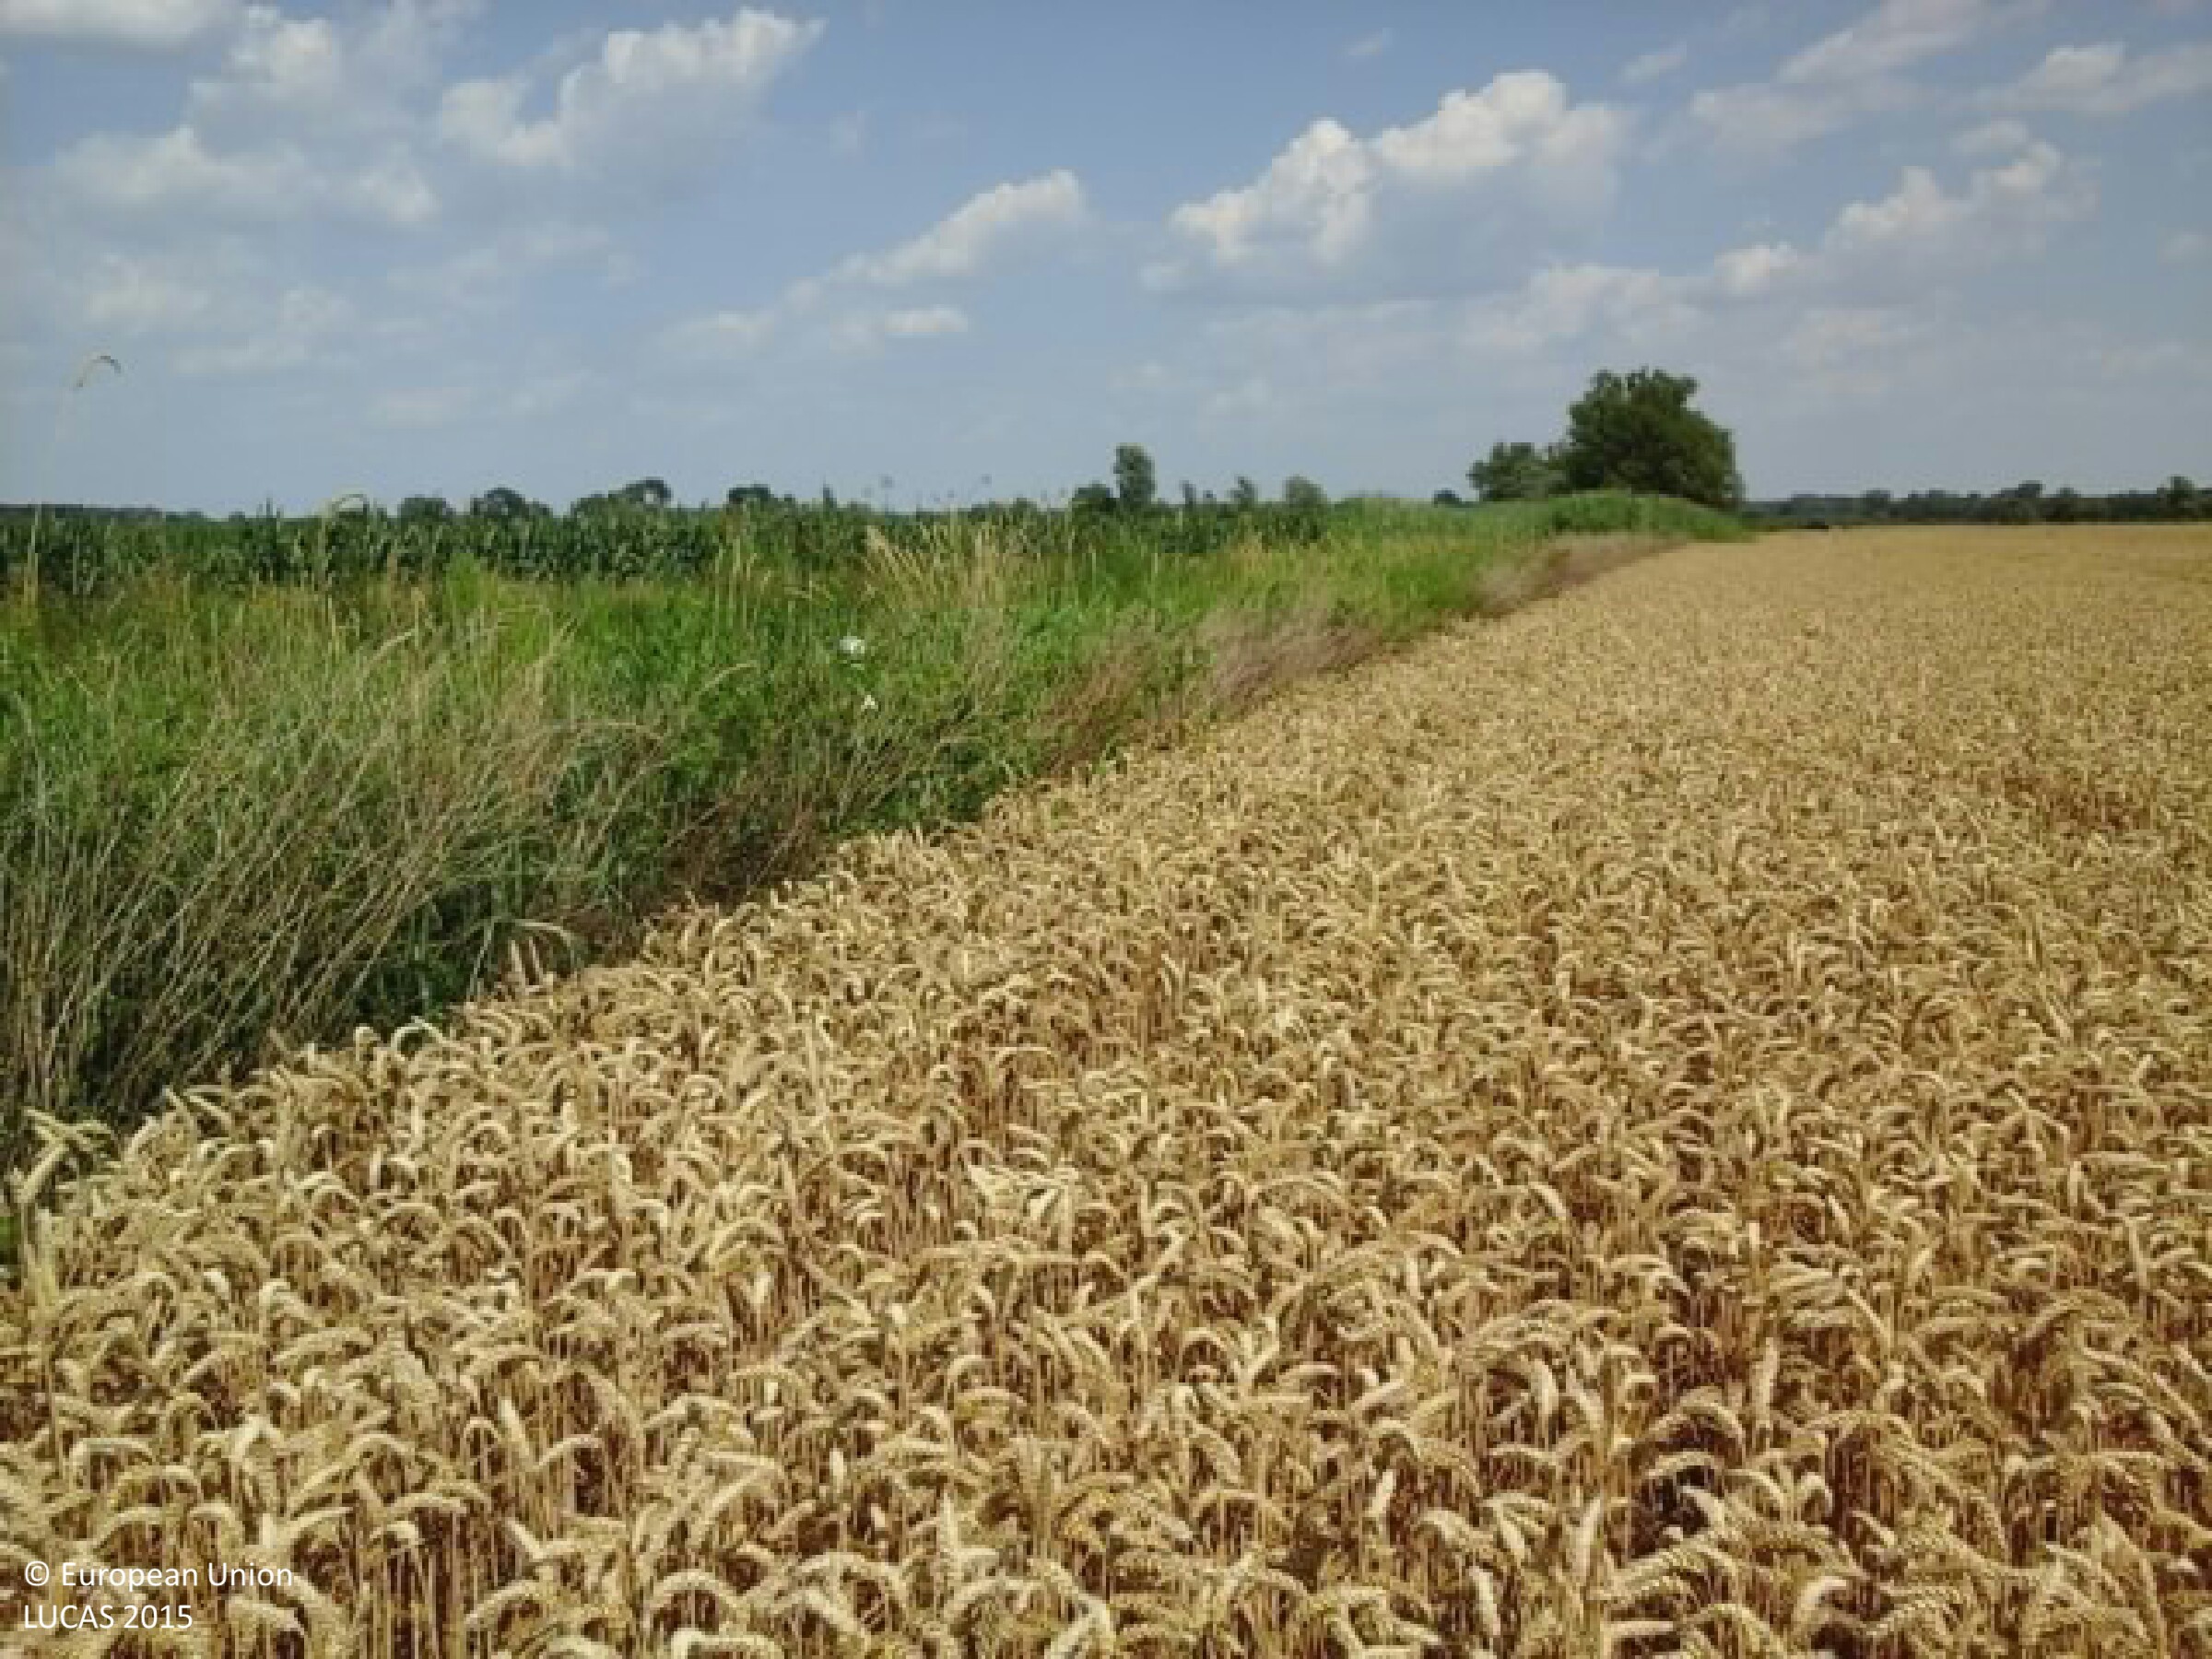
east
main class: Cropland
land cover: Common wheat
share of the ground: > 75 %
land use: Agriculture (excluding fallow land and kitchen gardens)
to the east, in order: Common wheat; Grass margins; Inland fresh running water; Grass margins; Maize
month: July
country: HU
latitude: 45.9121
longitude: 18.8412
